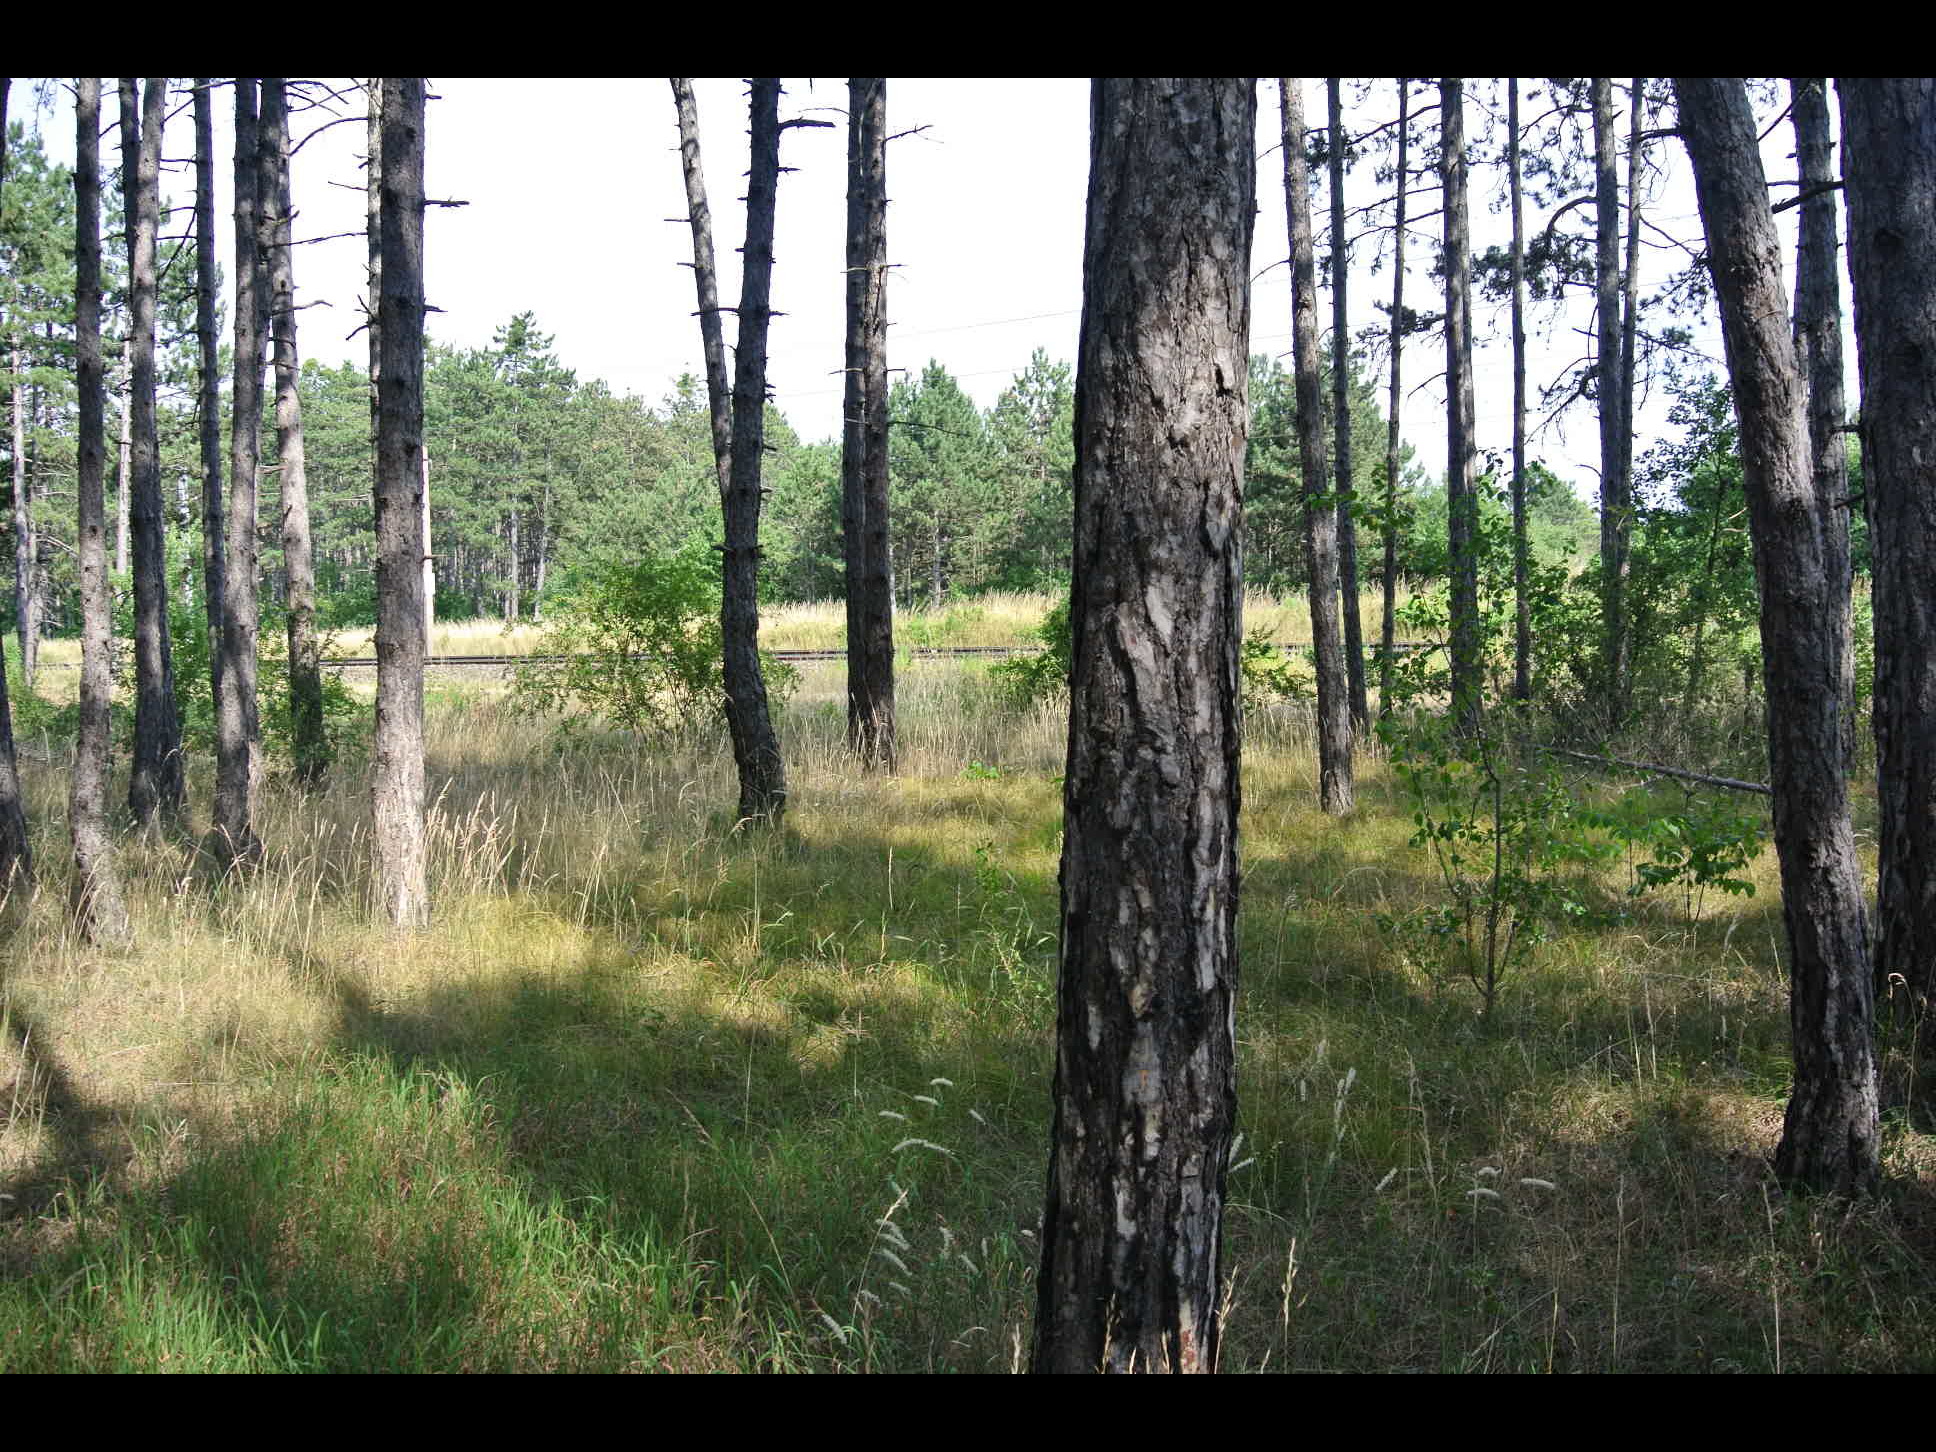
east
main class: Woodland
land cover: Pine dominated coniferous woodland
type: alpine coniferous forest
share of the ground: > 75 %
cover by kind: coniferous forest trees 90 %, herbaceous plants 10 %
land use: Forestry
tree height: > 5 m
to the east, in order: Pine dominated coniferous woodland; Tracks; Grassland without tree/shrub cover; Electric lines; Railways; Electric lines; Grassland without tree/shrub cover; Tracks; Fences; Pine dominated coniferous woodland; Tracks; Pine dominated coniferous woodland
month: July
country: AT
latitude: 47.7793
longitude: 16.1826
